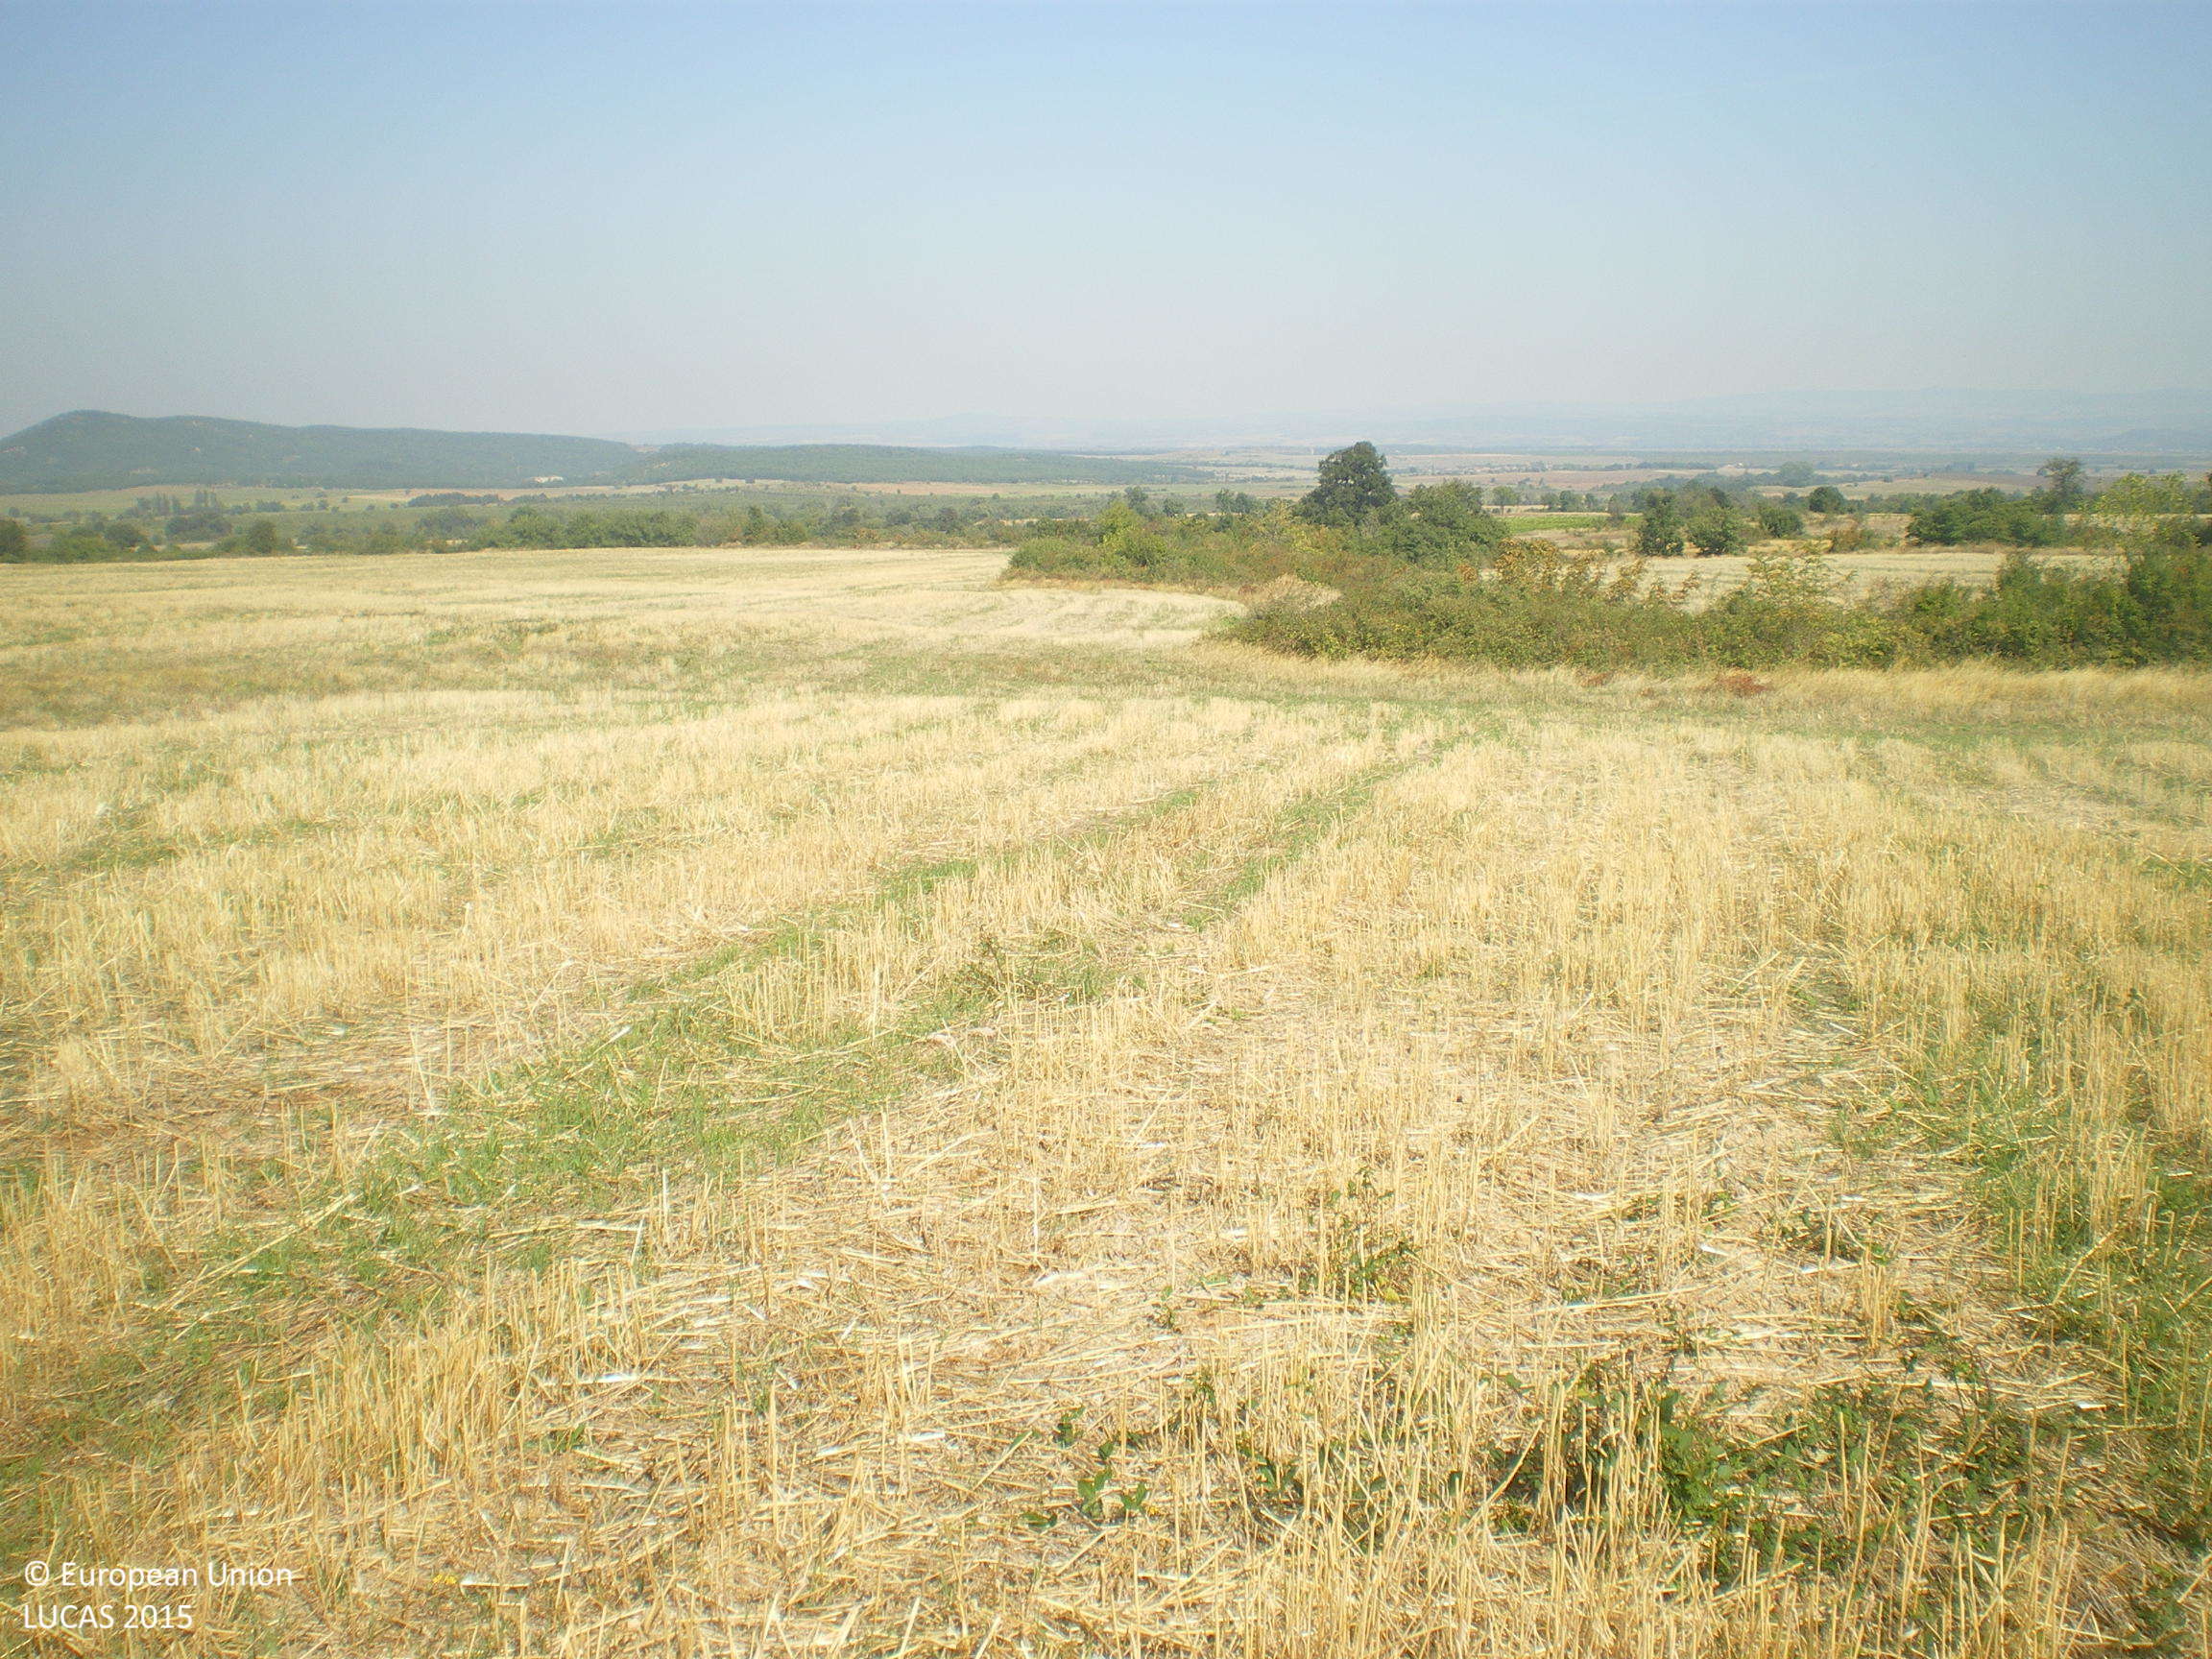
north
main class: Cropland
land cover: Common wheat
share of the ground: 10 - 25 %
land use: Agriculture (excluding fallow land and kitchen gardens)
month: September
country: BG
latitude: 41.7572
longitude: 26.0074
